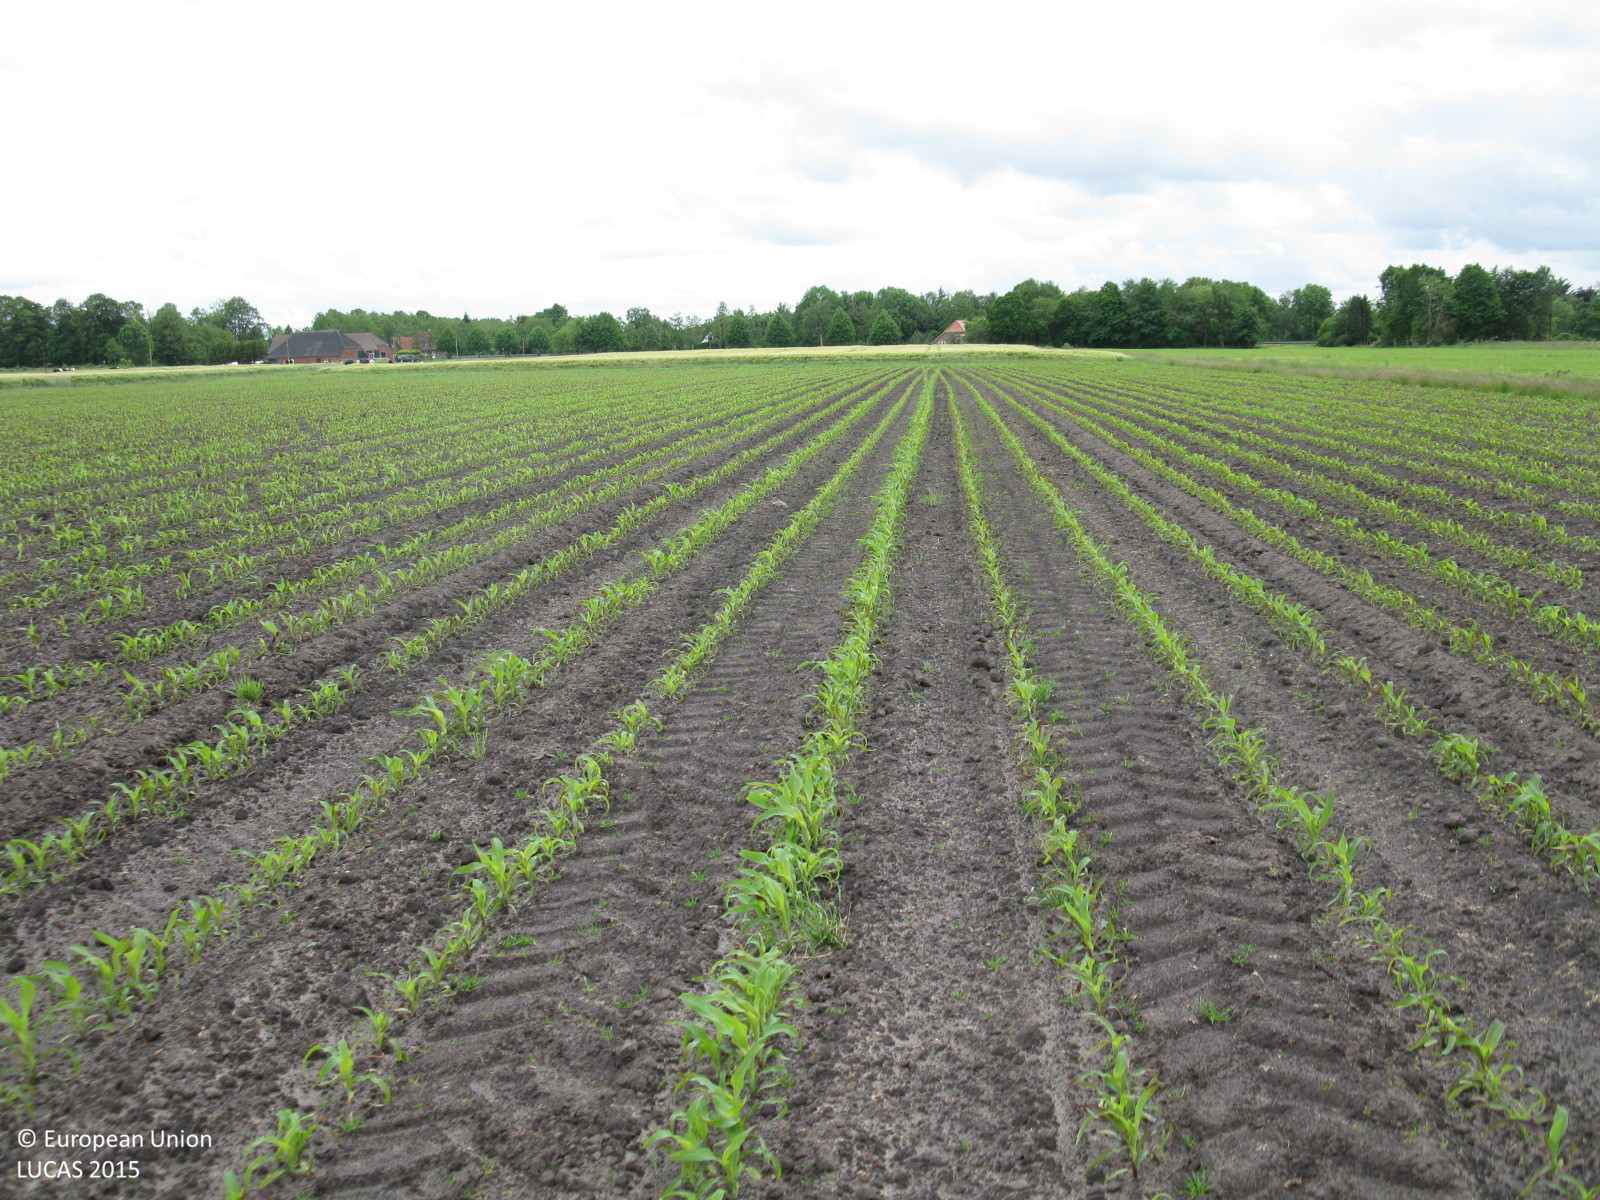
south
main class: Cropland
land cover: Maize
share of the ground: 10 - 25 %
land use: Agriculture (excluding fallow land and kitchen gardens)
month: June
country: DE
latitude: 53.5703
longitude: 7.3279
